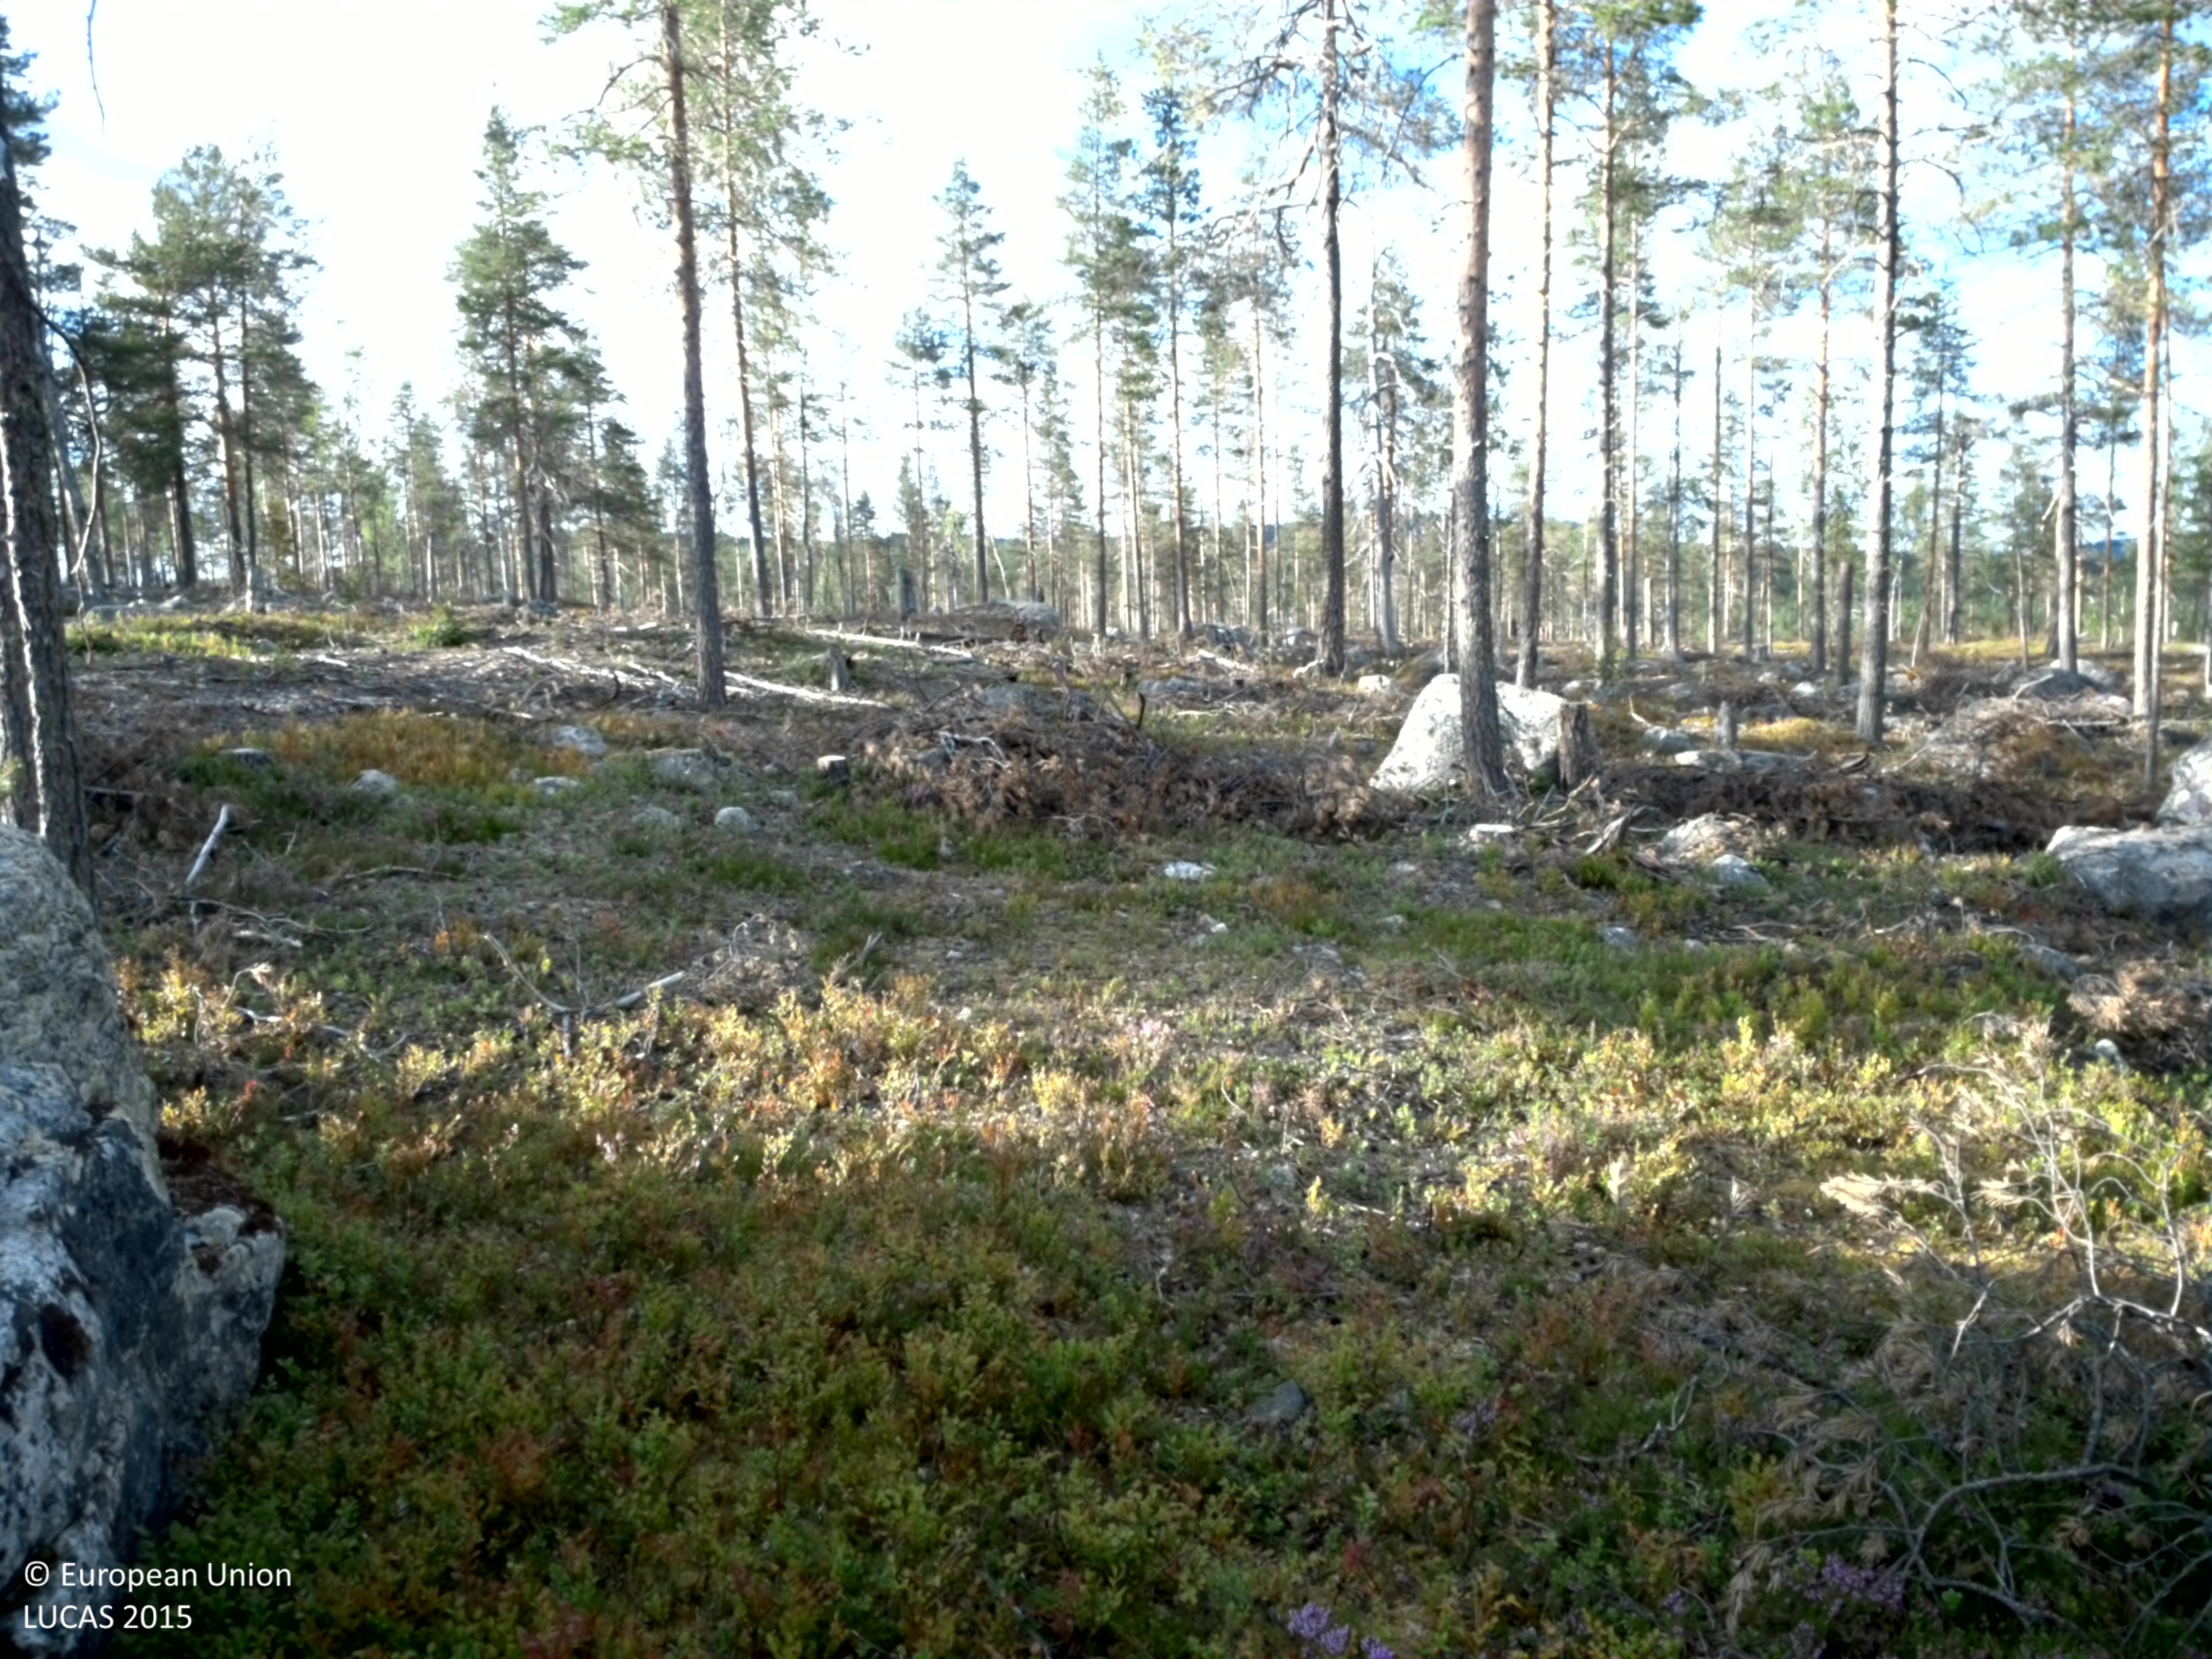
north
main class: Woodland
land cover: Pine dominated coniferous woodland
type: boreal forest
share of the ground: 10 - 25 %
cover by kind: shrubs 40 %, consolidated bare surface 25 %, lichens and mosses 20 %, coniferous forest trees 15 %
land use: Forestry
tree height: > 5 m
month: August
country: SE
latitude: 66.1569
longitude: 22.7711
